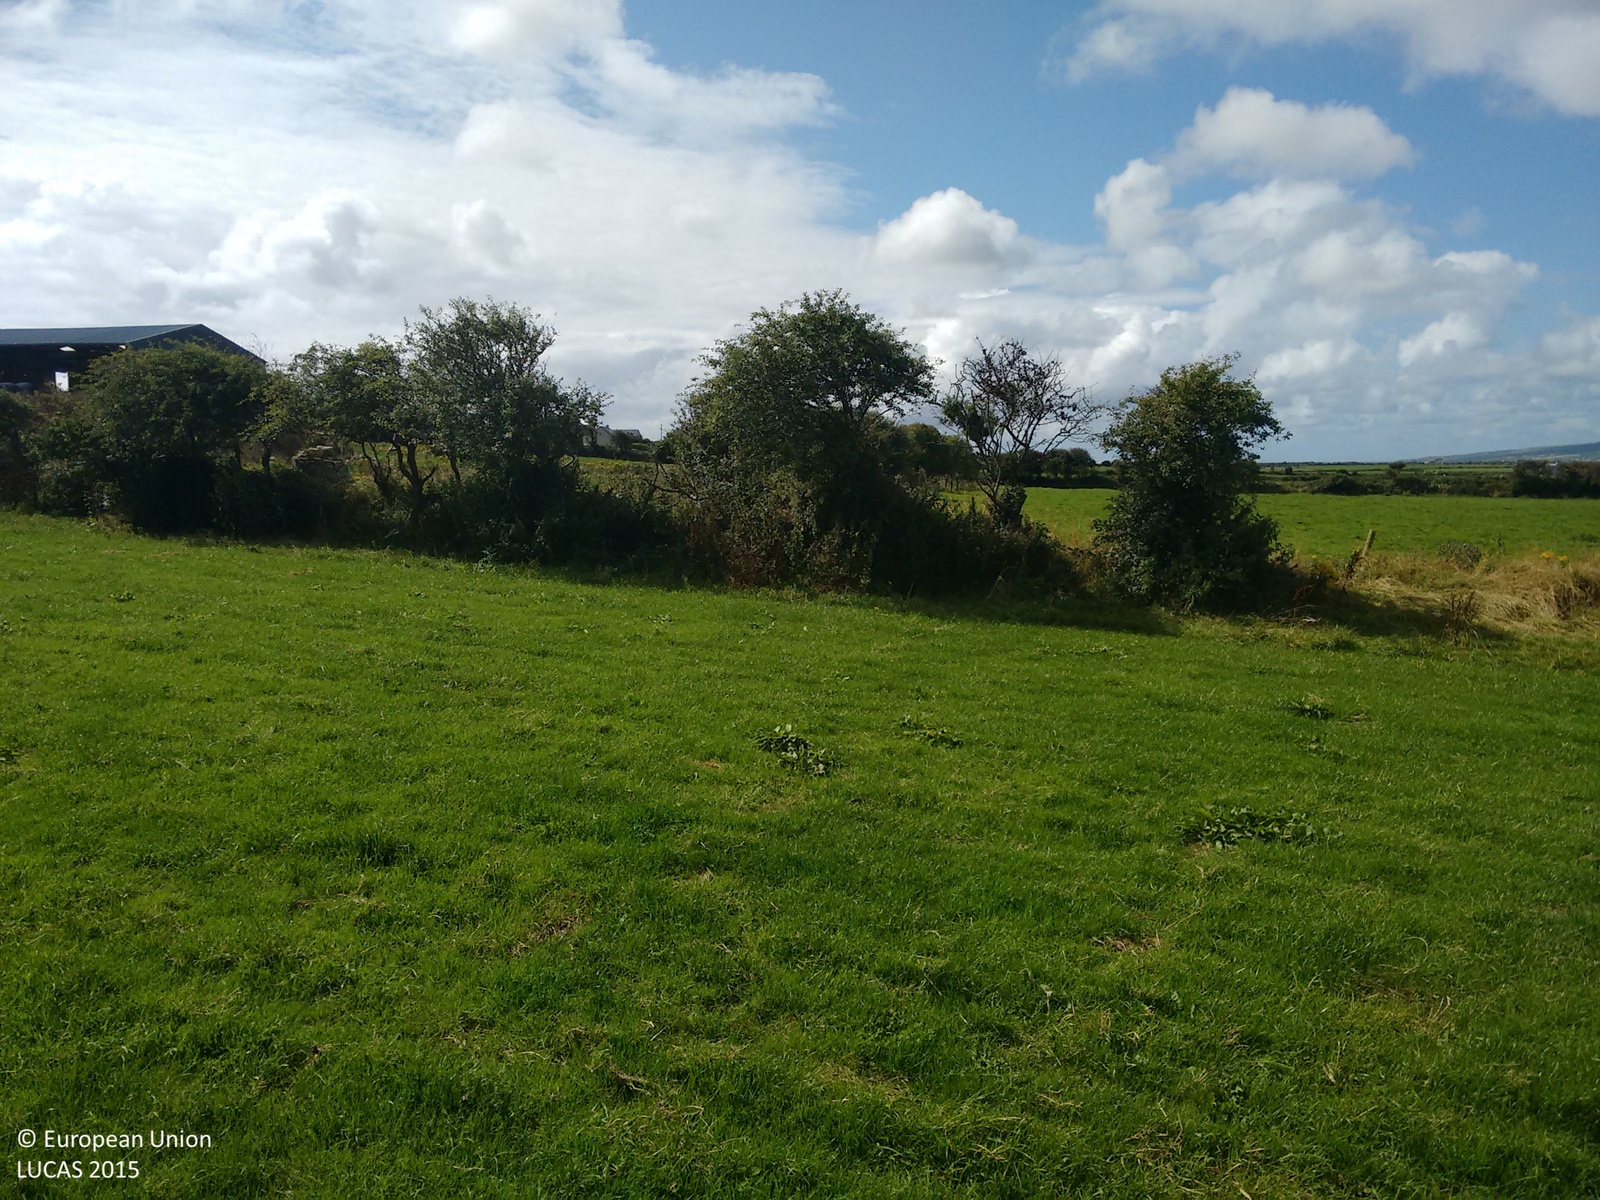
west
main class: Grassland
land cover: Grassland without tree/shrub cover
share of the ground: > 75 %
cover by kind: herbaceous plants 90 %, shrubs 5 %, unconsolidated bare surface 5 %
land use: Agriculture (excluding fallow land and kitchen gardens)
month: September
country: IE
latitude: 52.3606
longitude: -9.7593
